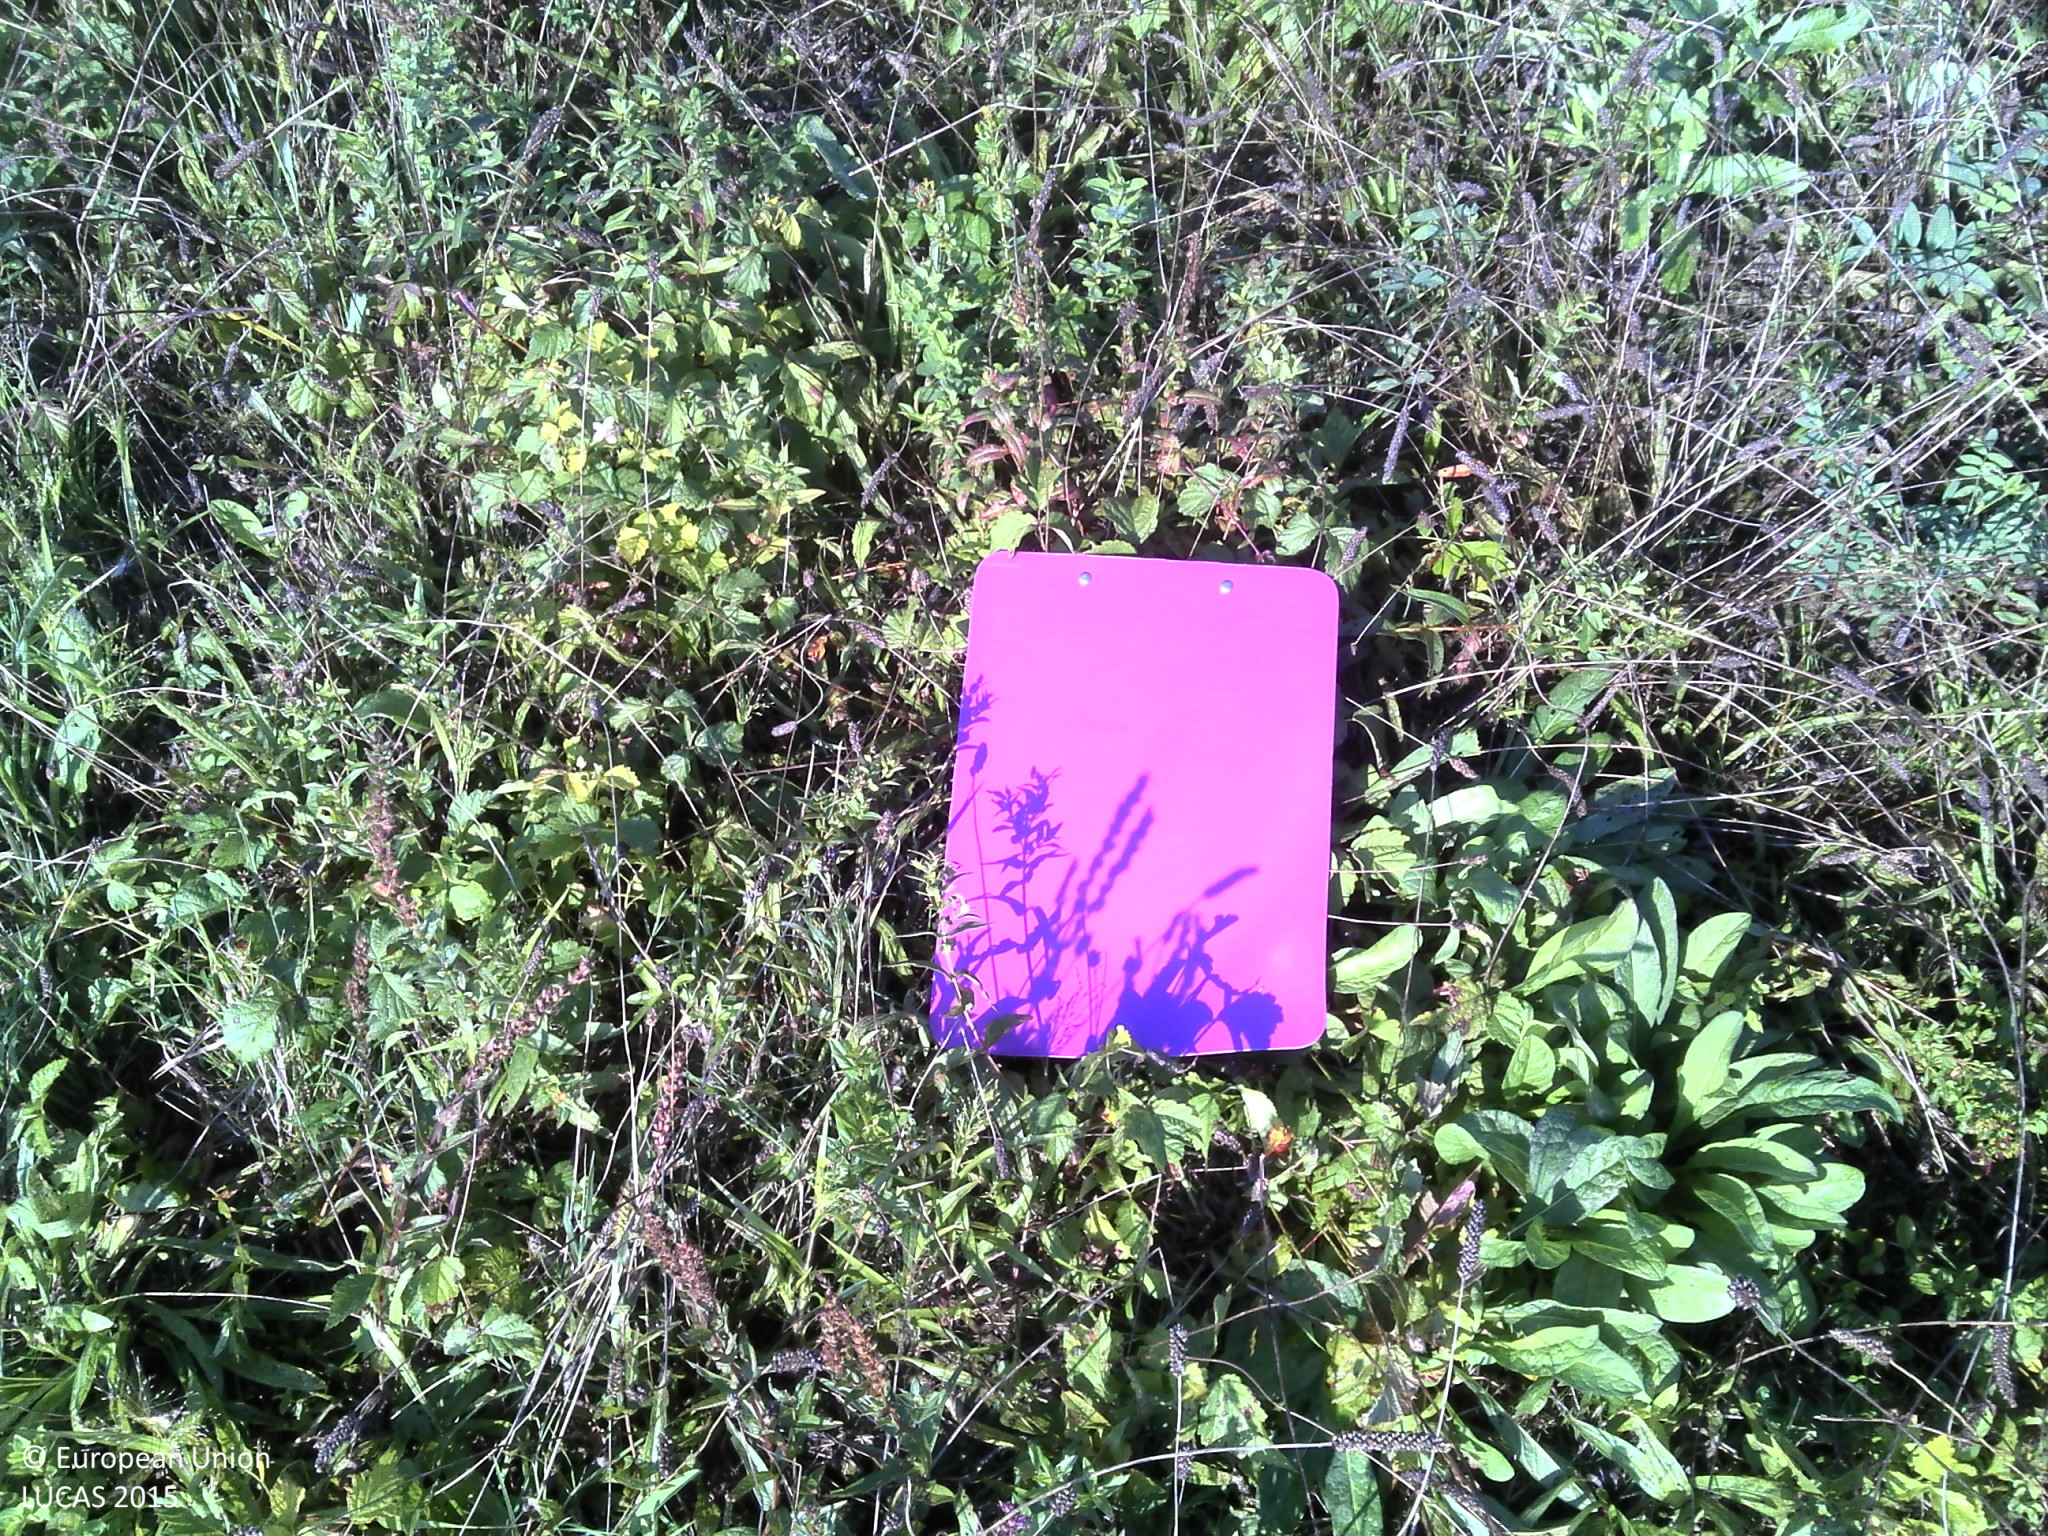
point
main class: Grassland
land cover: Grassland without tree/shrub cover
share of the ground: > 75 %
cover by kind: herbaceous plants 100 %
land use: Agriculture (excluding fallow land and kitchen gardens)
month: September
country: HR
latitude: 45.5817
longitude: 16.3935
